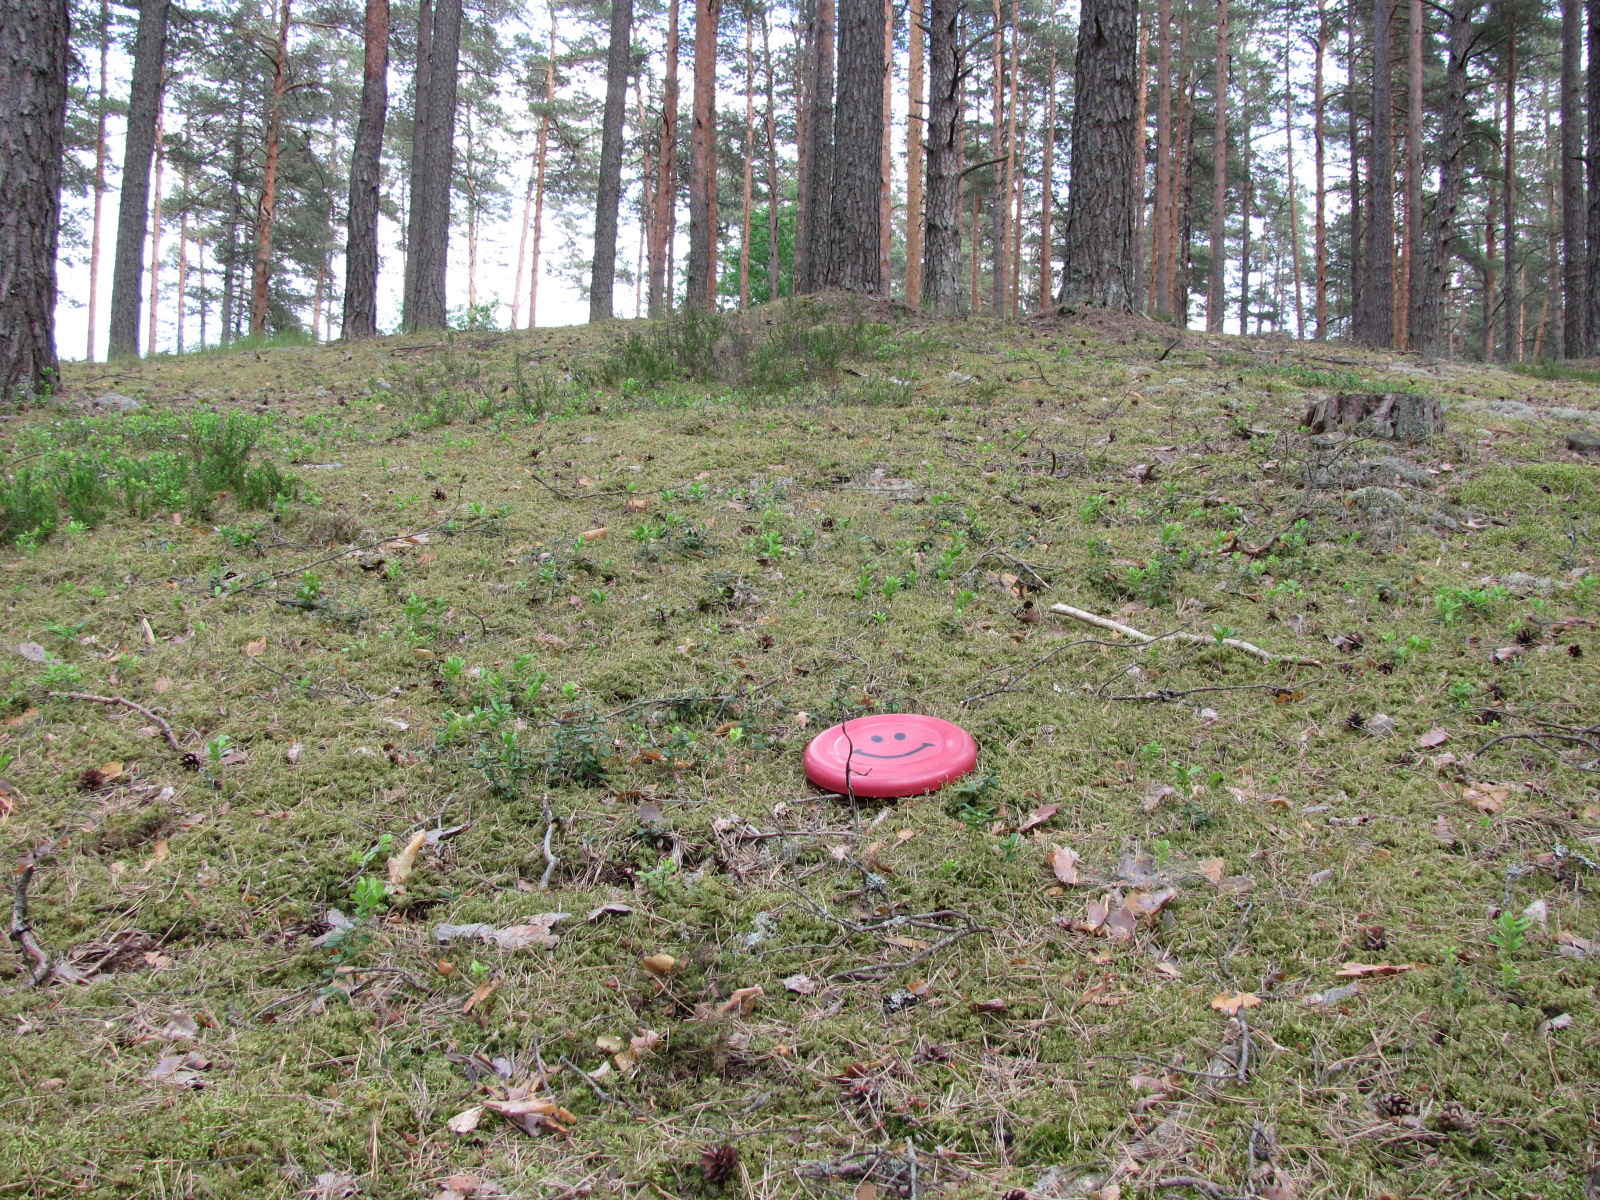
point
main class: Woodland
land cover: Pine dominated coniferous woodland
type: hemiboreal forest and nemoral coniferous forest and mixed broadleaved-coniferous forest
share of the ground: > 75 %
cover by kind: coniferous forest trees 85 %, lichens and mosses 15 %
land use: Forestry
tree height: > 5 m
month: June
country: LV
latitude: 56.9602
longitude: 24.4157
